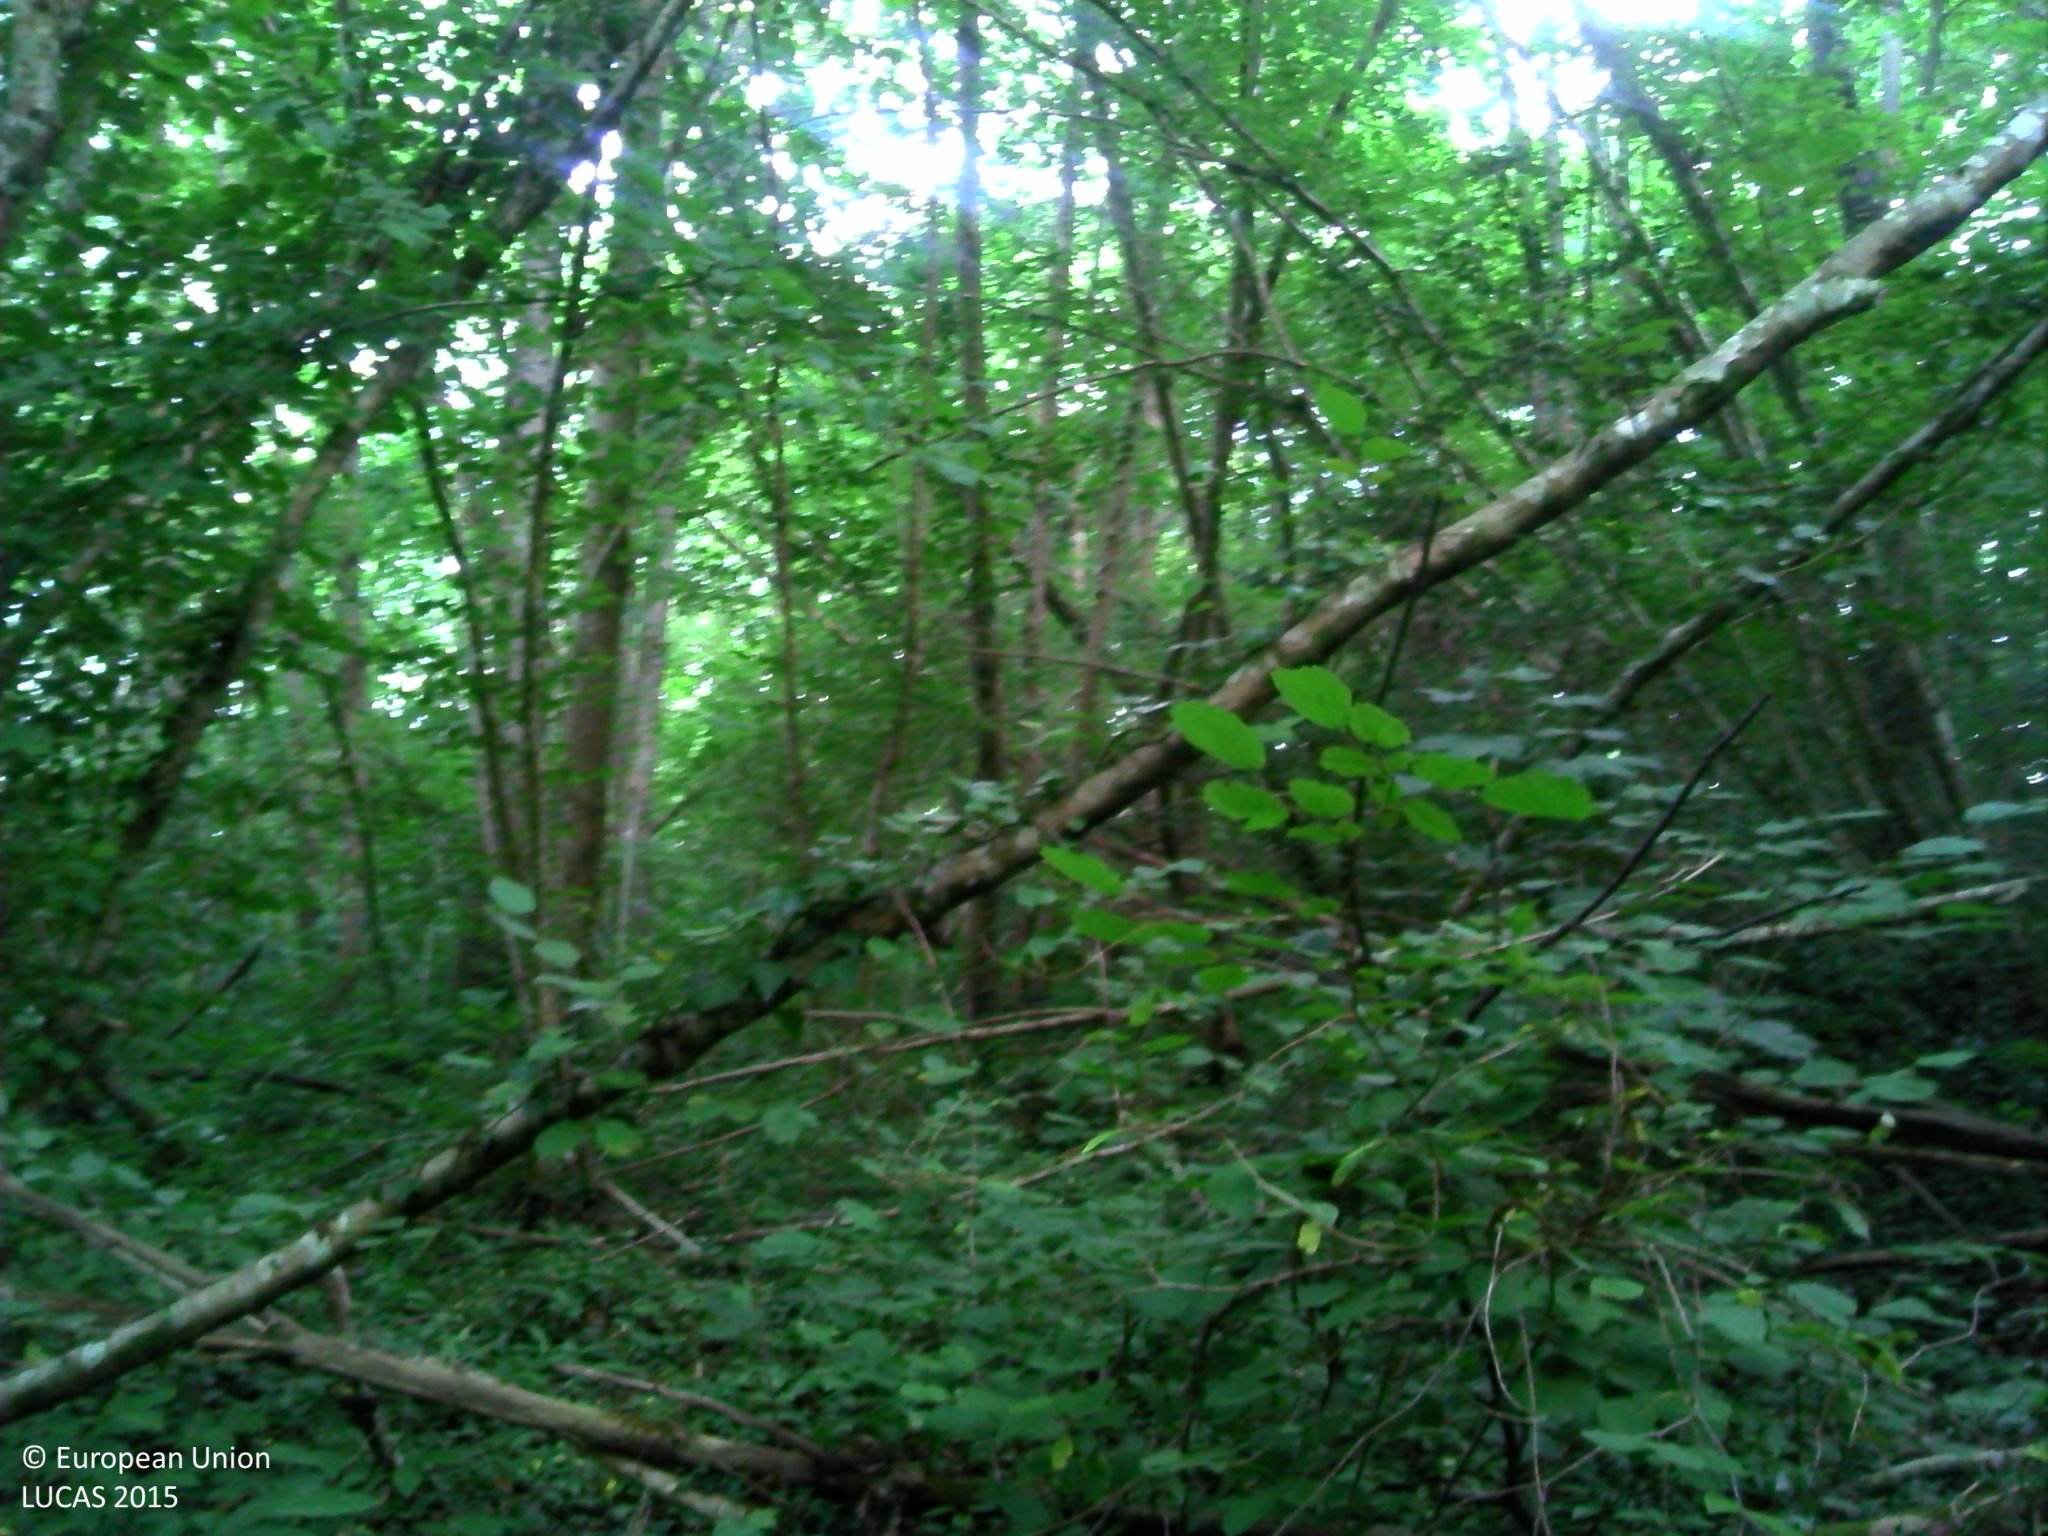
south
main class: Woodland
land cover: Broadleaved woodland
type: thermophilous deciduous forest
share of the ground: > 75 %
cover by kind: broadleaved forest trees 90 %, shrubs 5 %, herbaceous plants 5 %
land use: Forestry
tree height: > 5 m
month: August
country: FR
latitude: 43.3576
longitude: -1.0561
